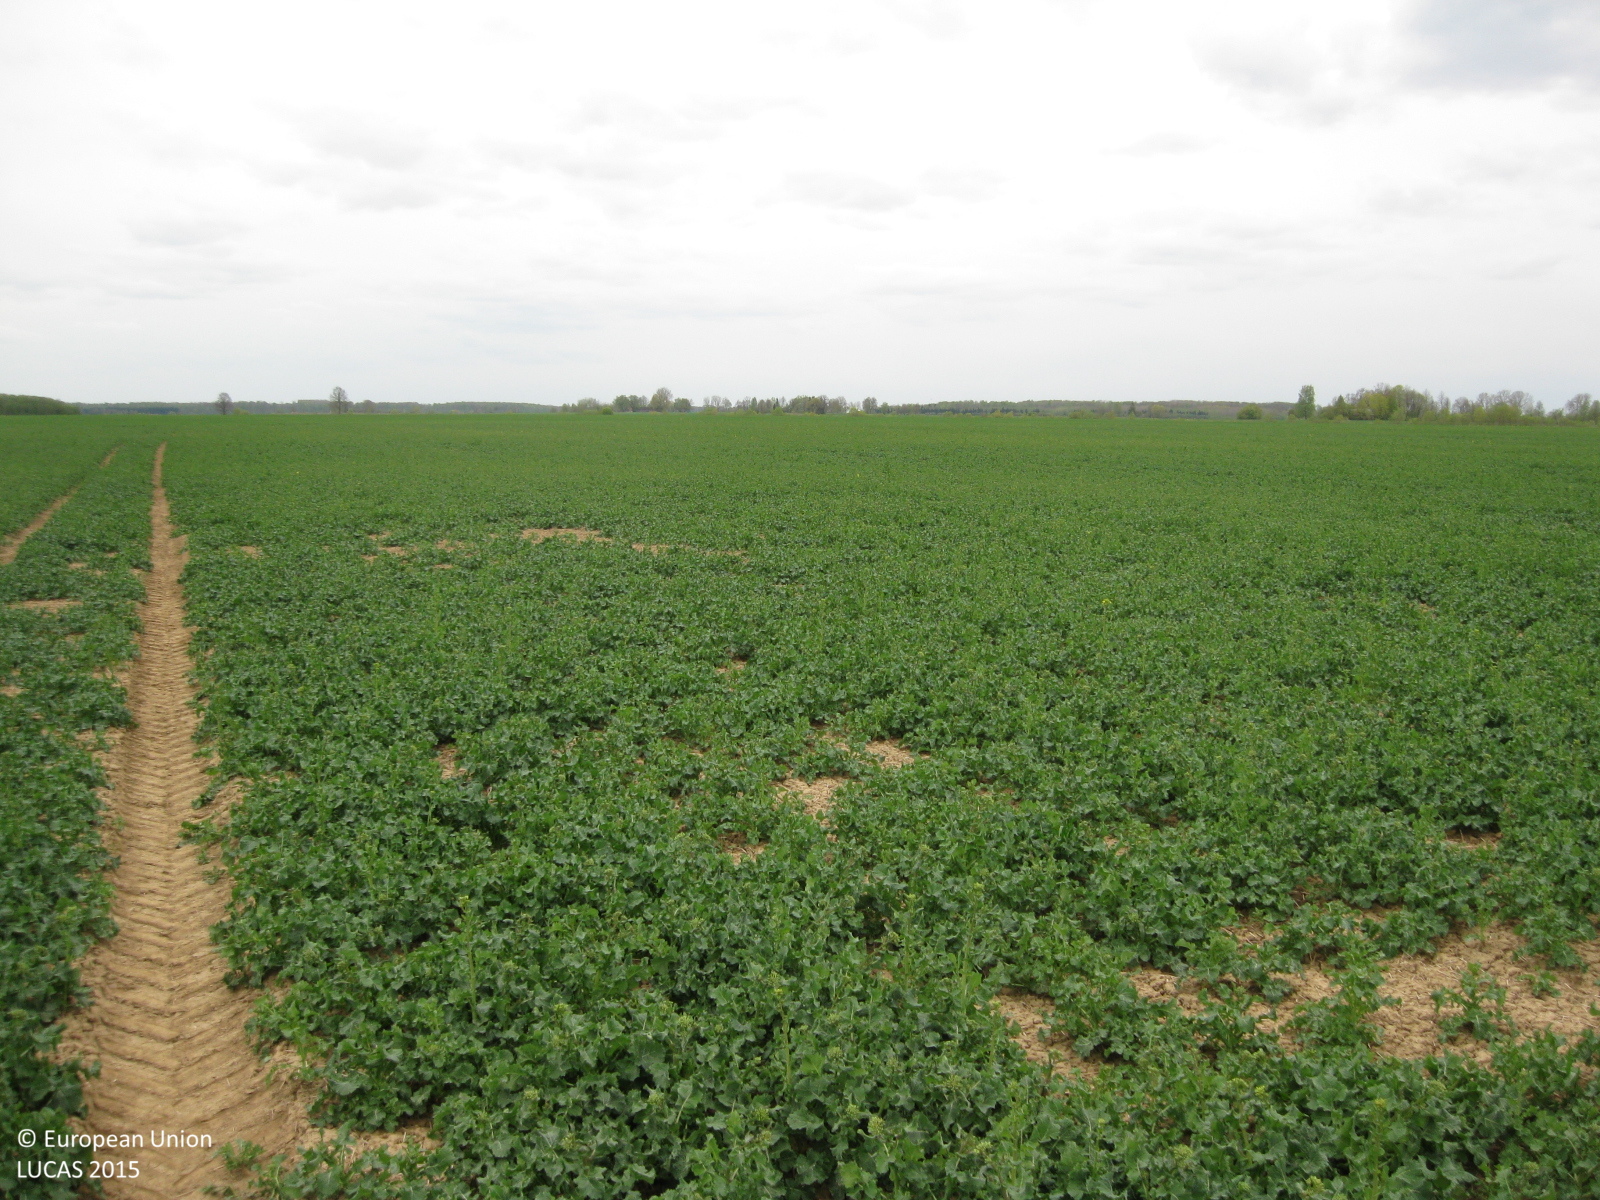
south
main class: Cropland
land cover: Rape and turnip rape
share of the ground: > 75 %
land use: Agriculture (excluding fallow land and kitchen gardens)
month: May
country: LT
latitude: 56.2010
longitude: 24.4910
